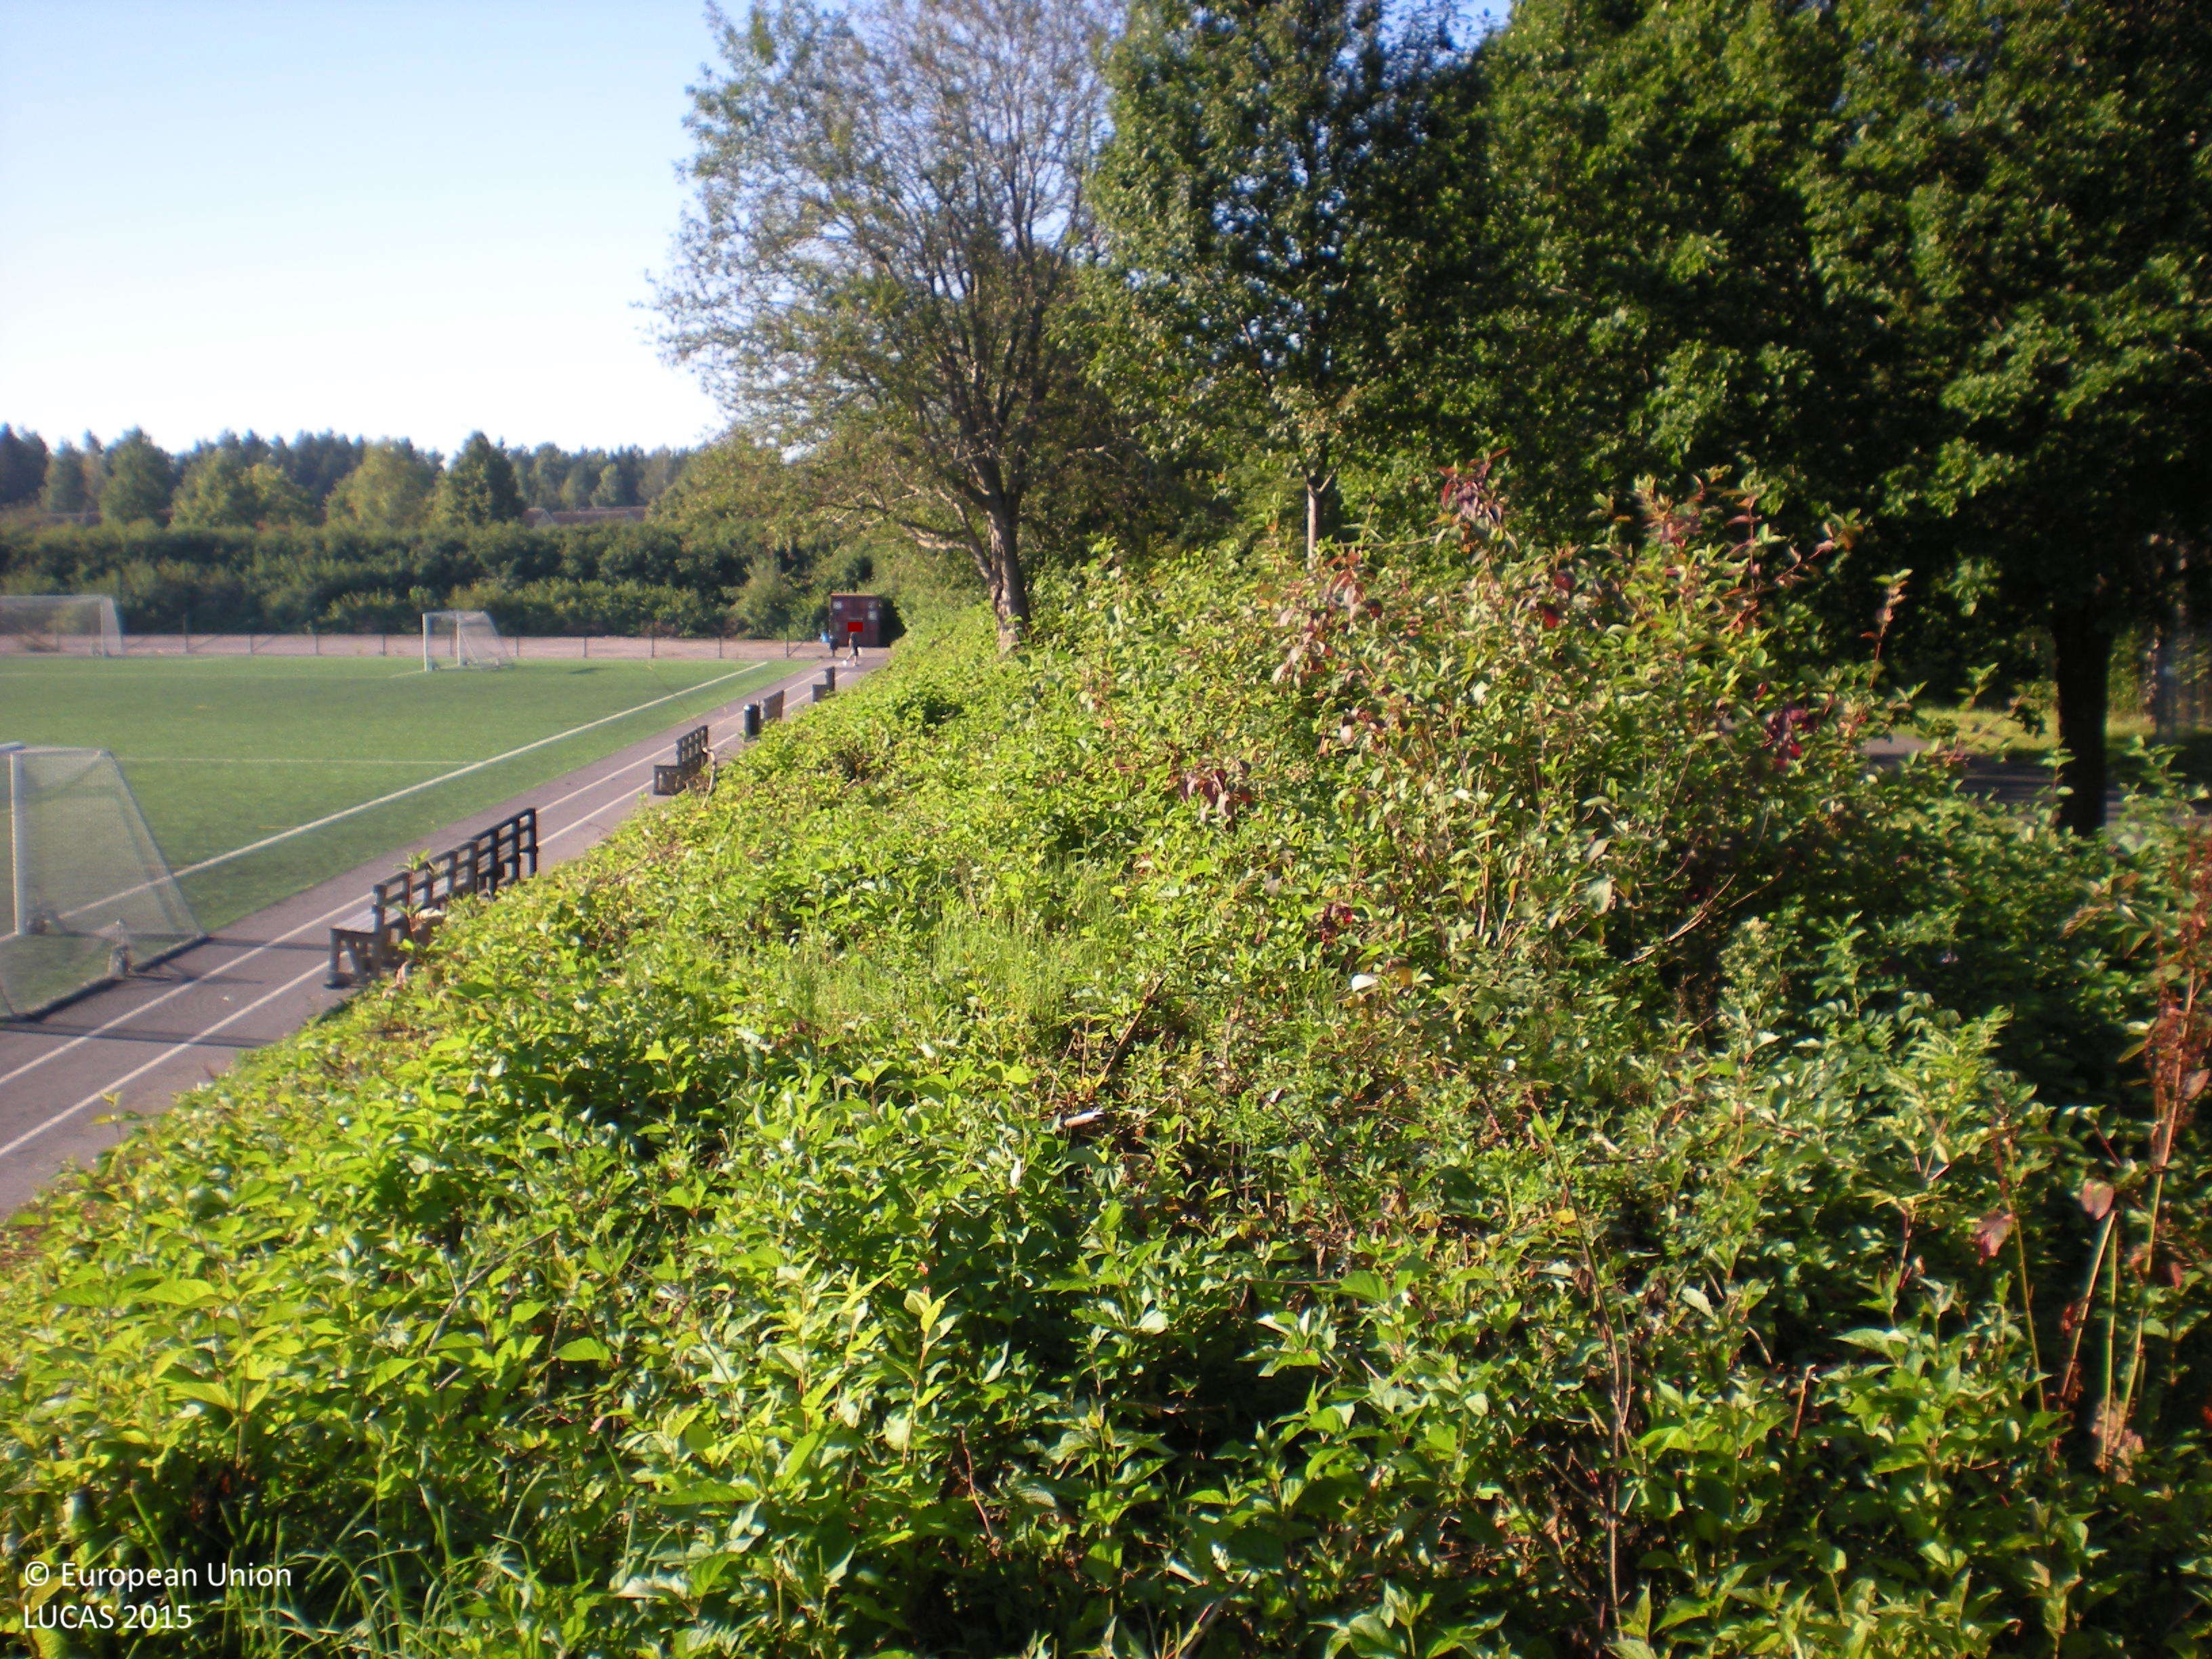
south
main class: Shrubland
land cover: Shrubland with sparse tree cover
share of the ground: > 75 %
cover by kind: shrubs 95 %, broadleaved forest trees 5 %
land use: Amenities, museums, leisure
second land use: Sport
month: August
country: SE
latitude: 60.6509
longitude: 17.1408
